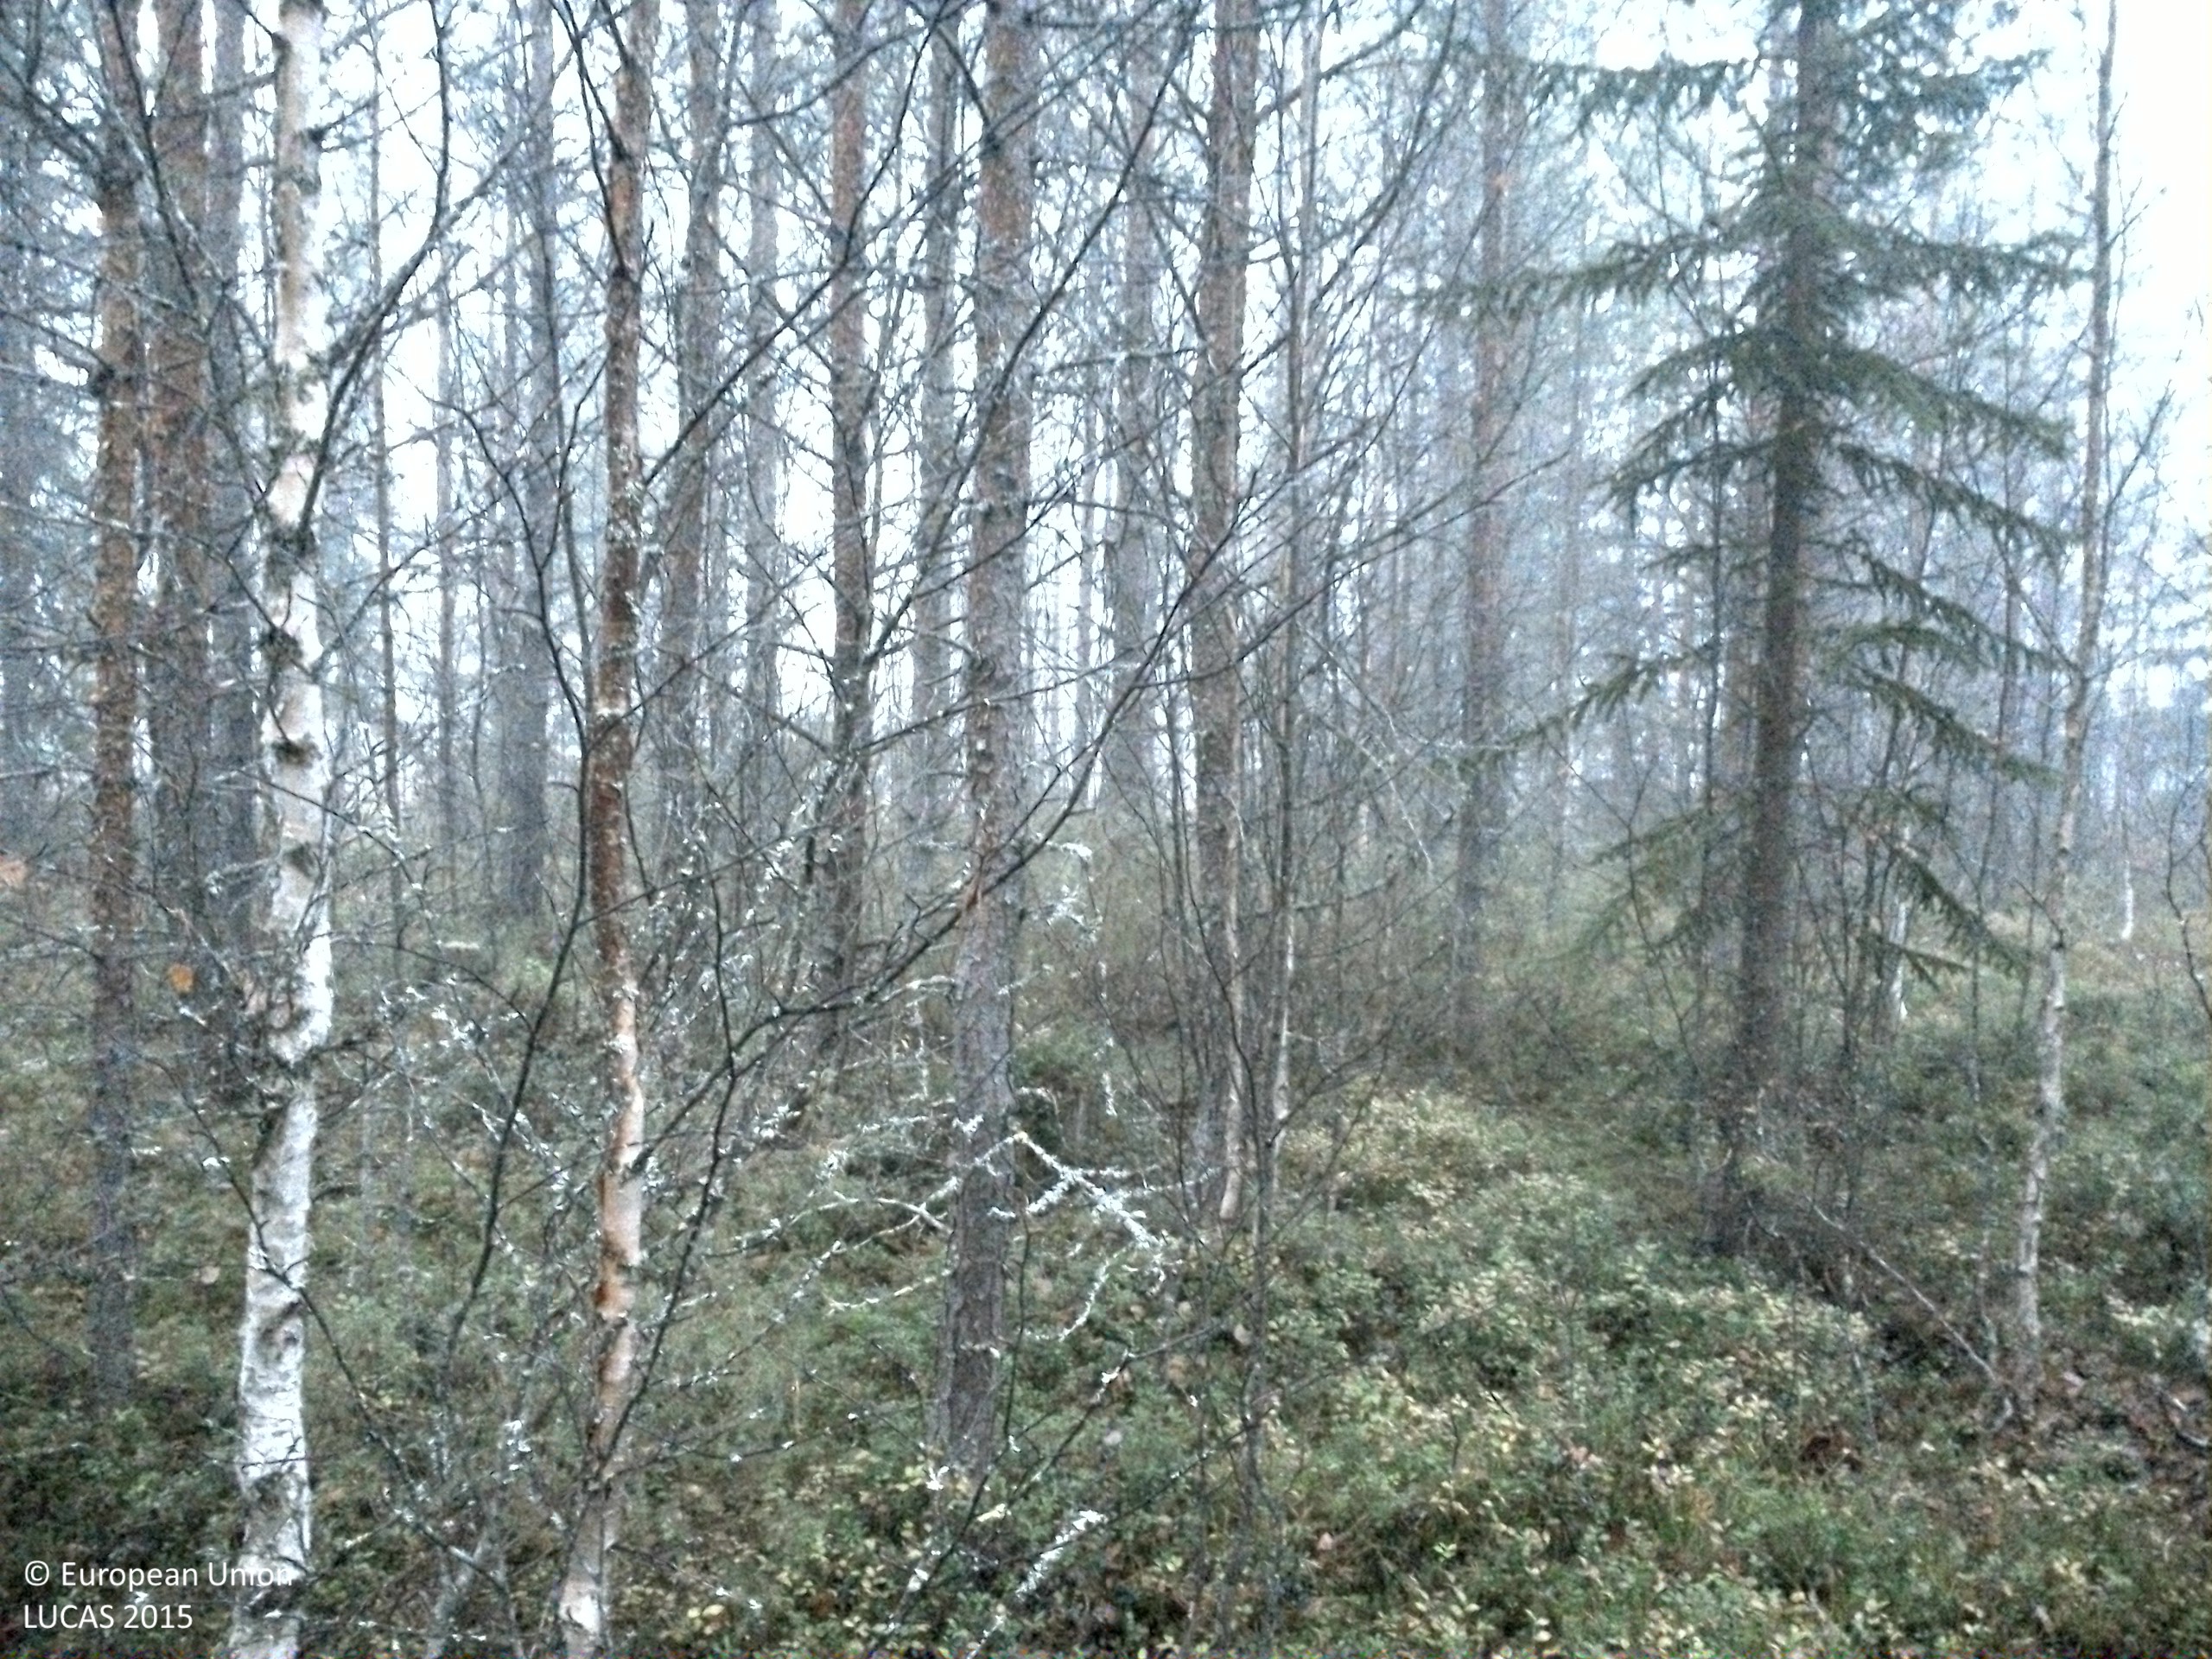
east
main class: Woodland
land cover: Pine dominated mixed woodland
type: boreal forest
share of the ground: 50 - 75 %
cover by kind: coniferous forest trees 45 %, shrubs 30 %, broadleaved forest trees 15 %, lichens and mosses 10 %
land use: Forestry
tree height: > 5 m
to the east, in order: Pine dominated mixed woodland; Peatbogs; Broadleaved woodland; Pine dominated coniferous woodland
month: October
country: SE
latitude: 64.0915
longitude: 16.3091
